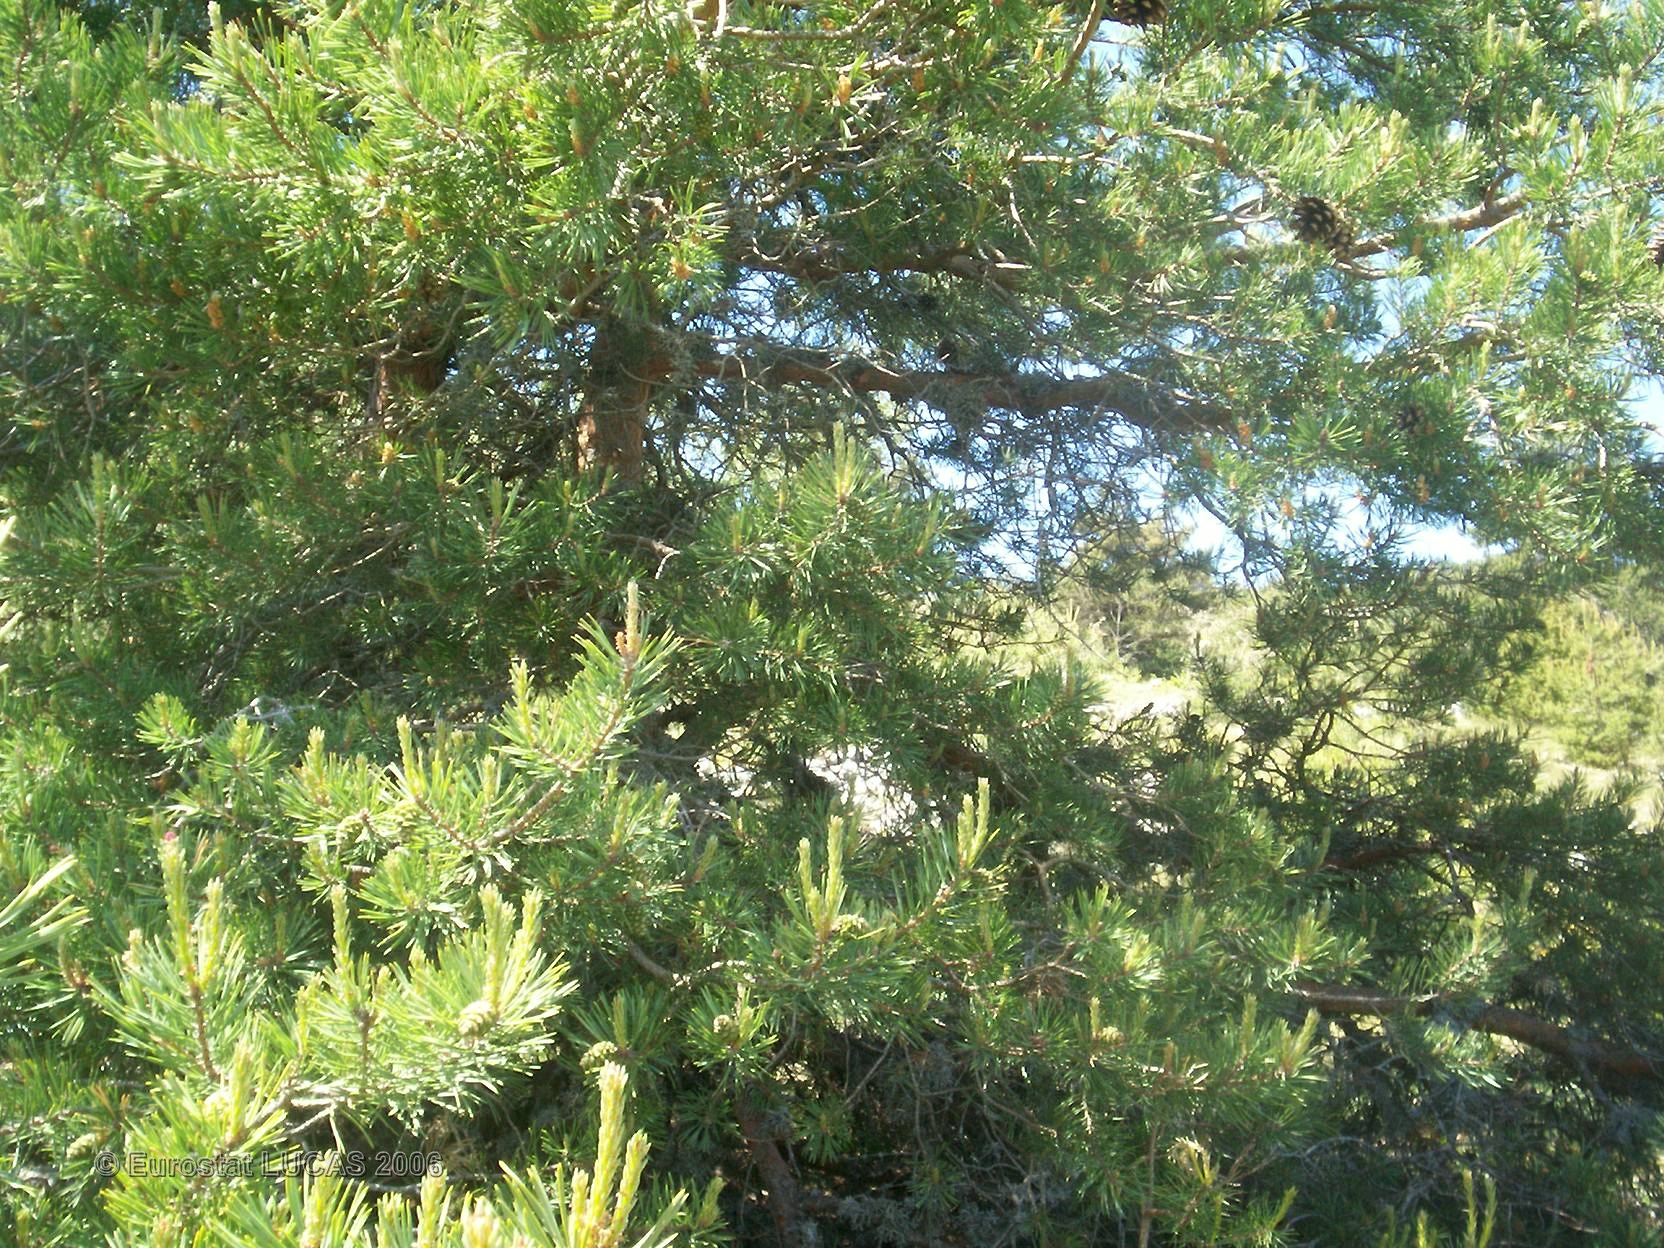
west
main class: Grassland
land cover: Grassland with sparse tree/shrub cover
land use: Agriculture (excluding fallow land and kitchen gardens)
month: June
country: FR
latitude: 44.2673
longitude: 3.4041
